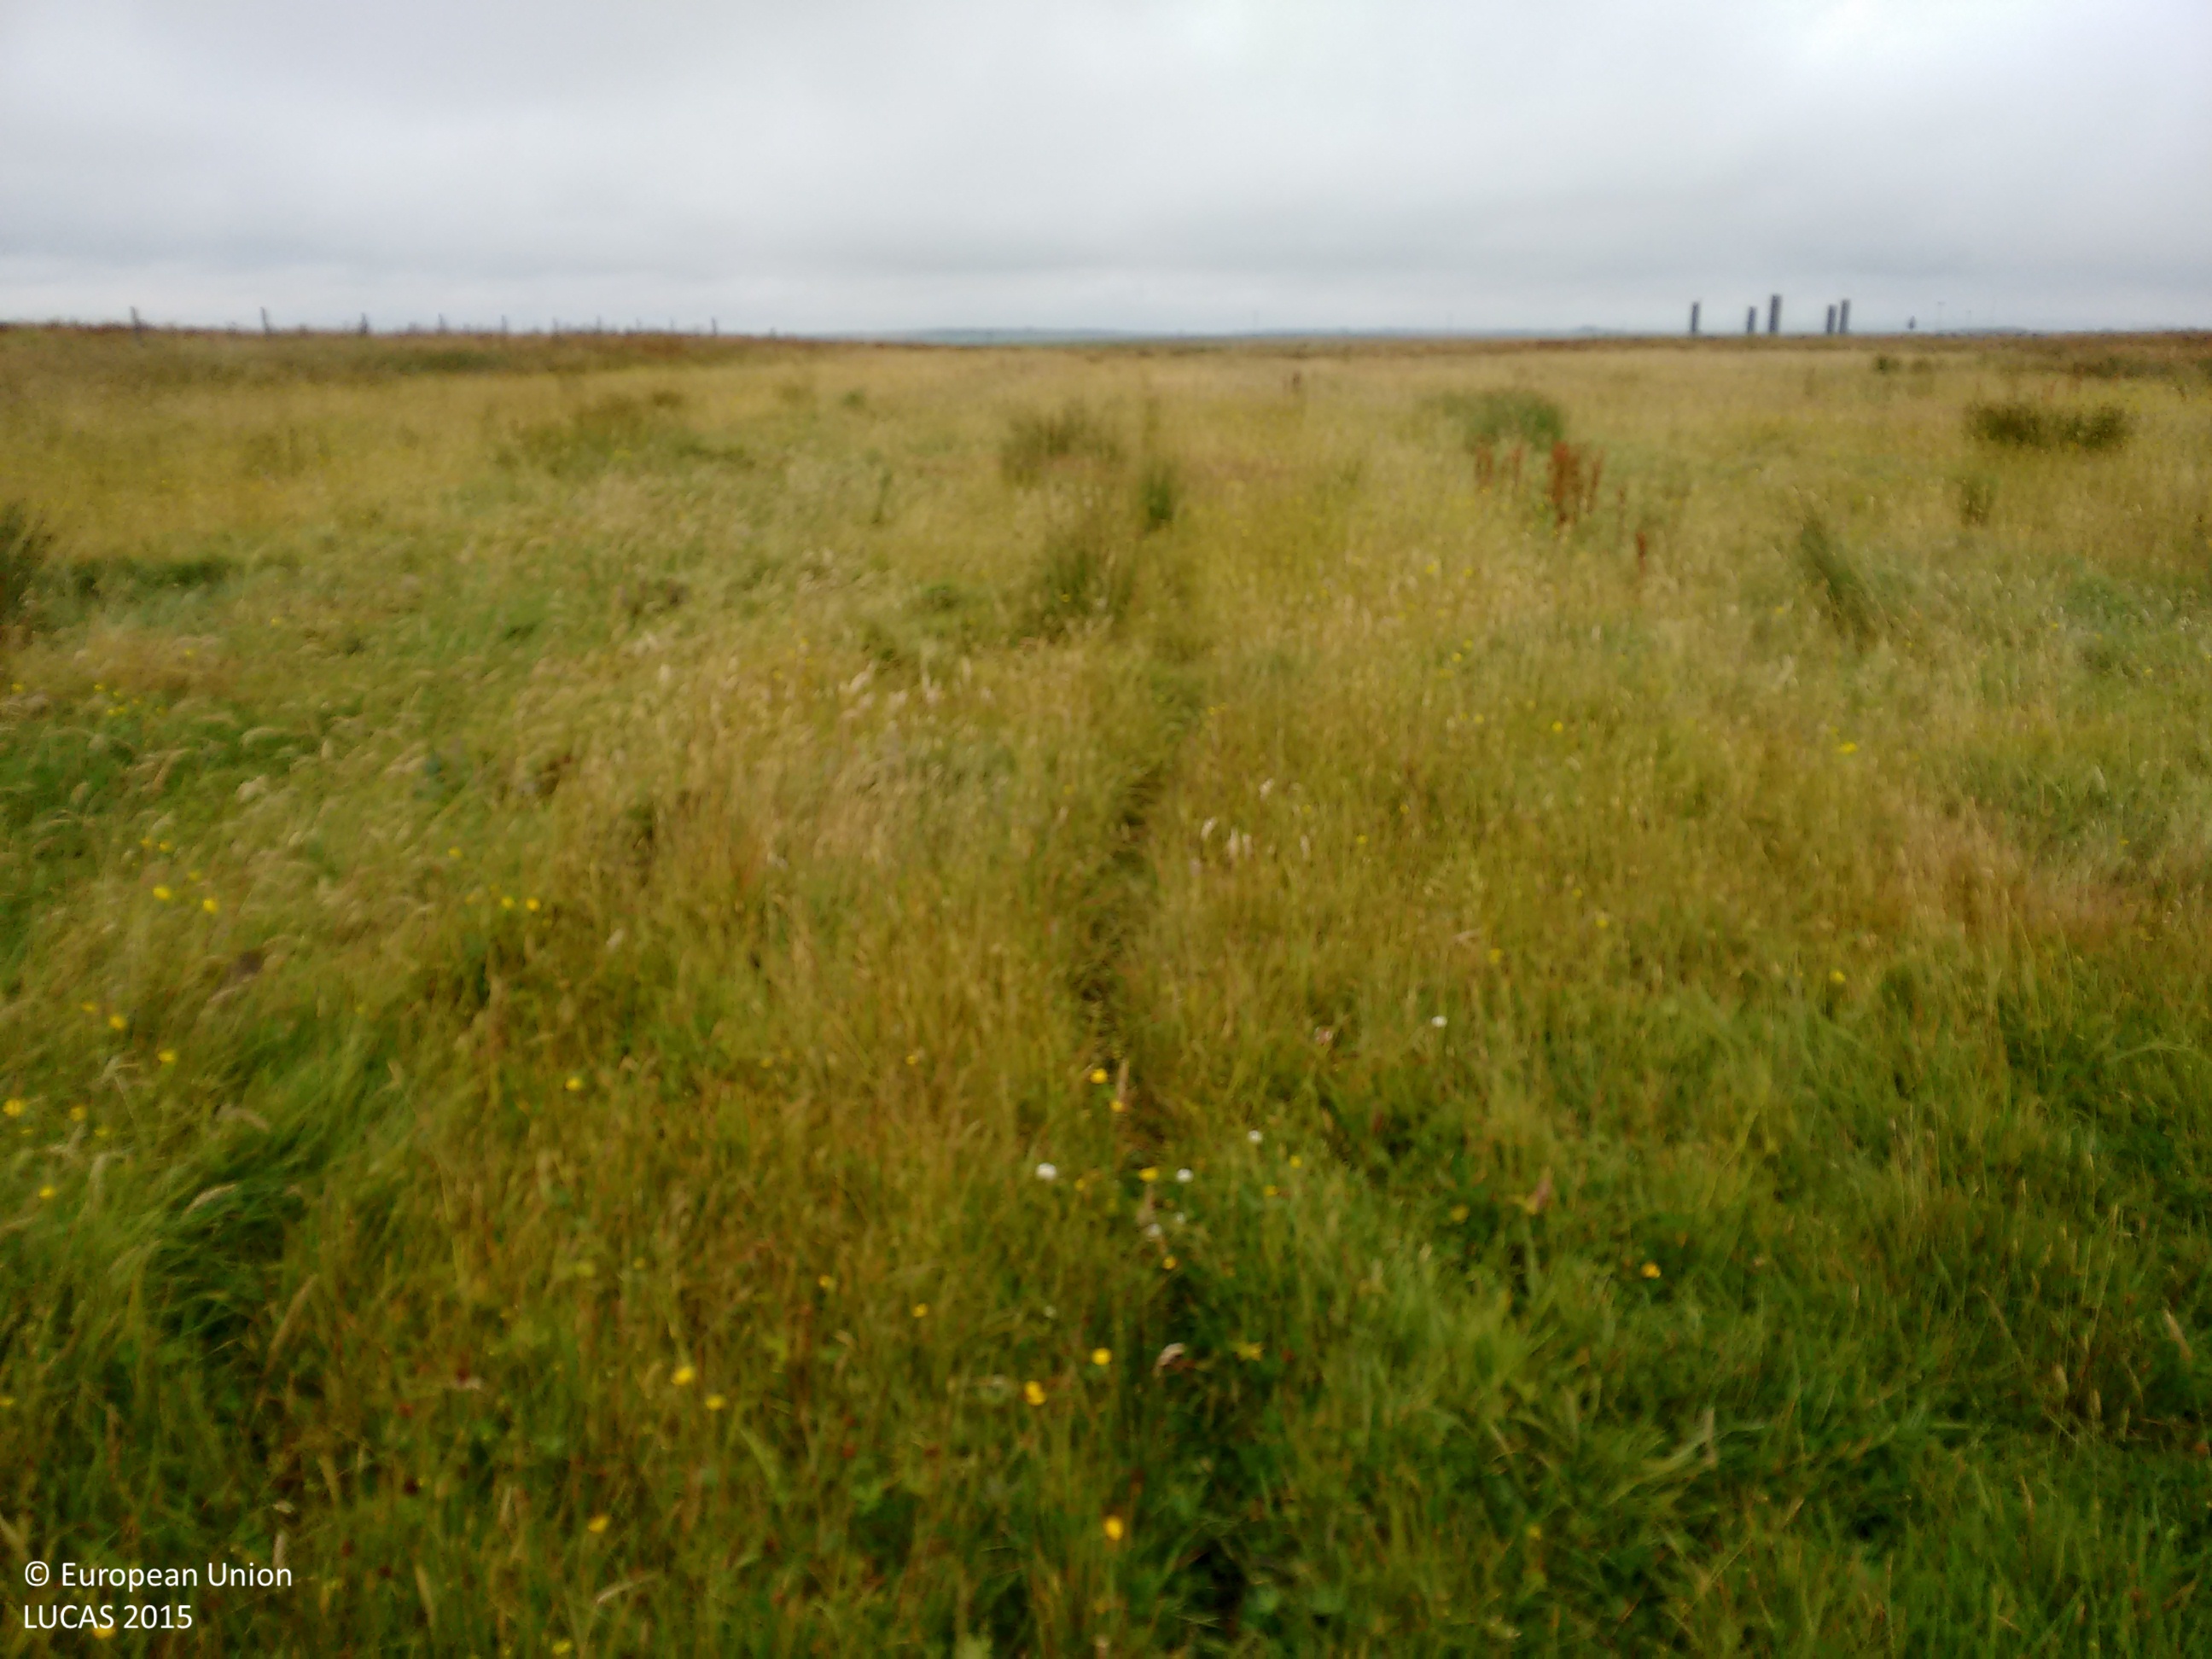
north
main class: Grassland
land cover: Grassland without tree/shrub cover
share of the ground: > 75 %
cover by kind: herbaceous plants 100 %
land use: Agriculture (excluding fallow land and kitchen gardens)
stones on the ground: < 10 %
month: August
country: GB
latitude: 58.4306
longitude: -3.1249
